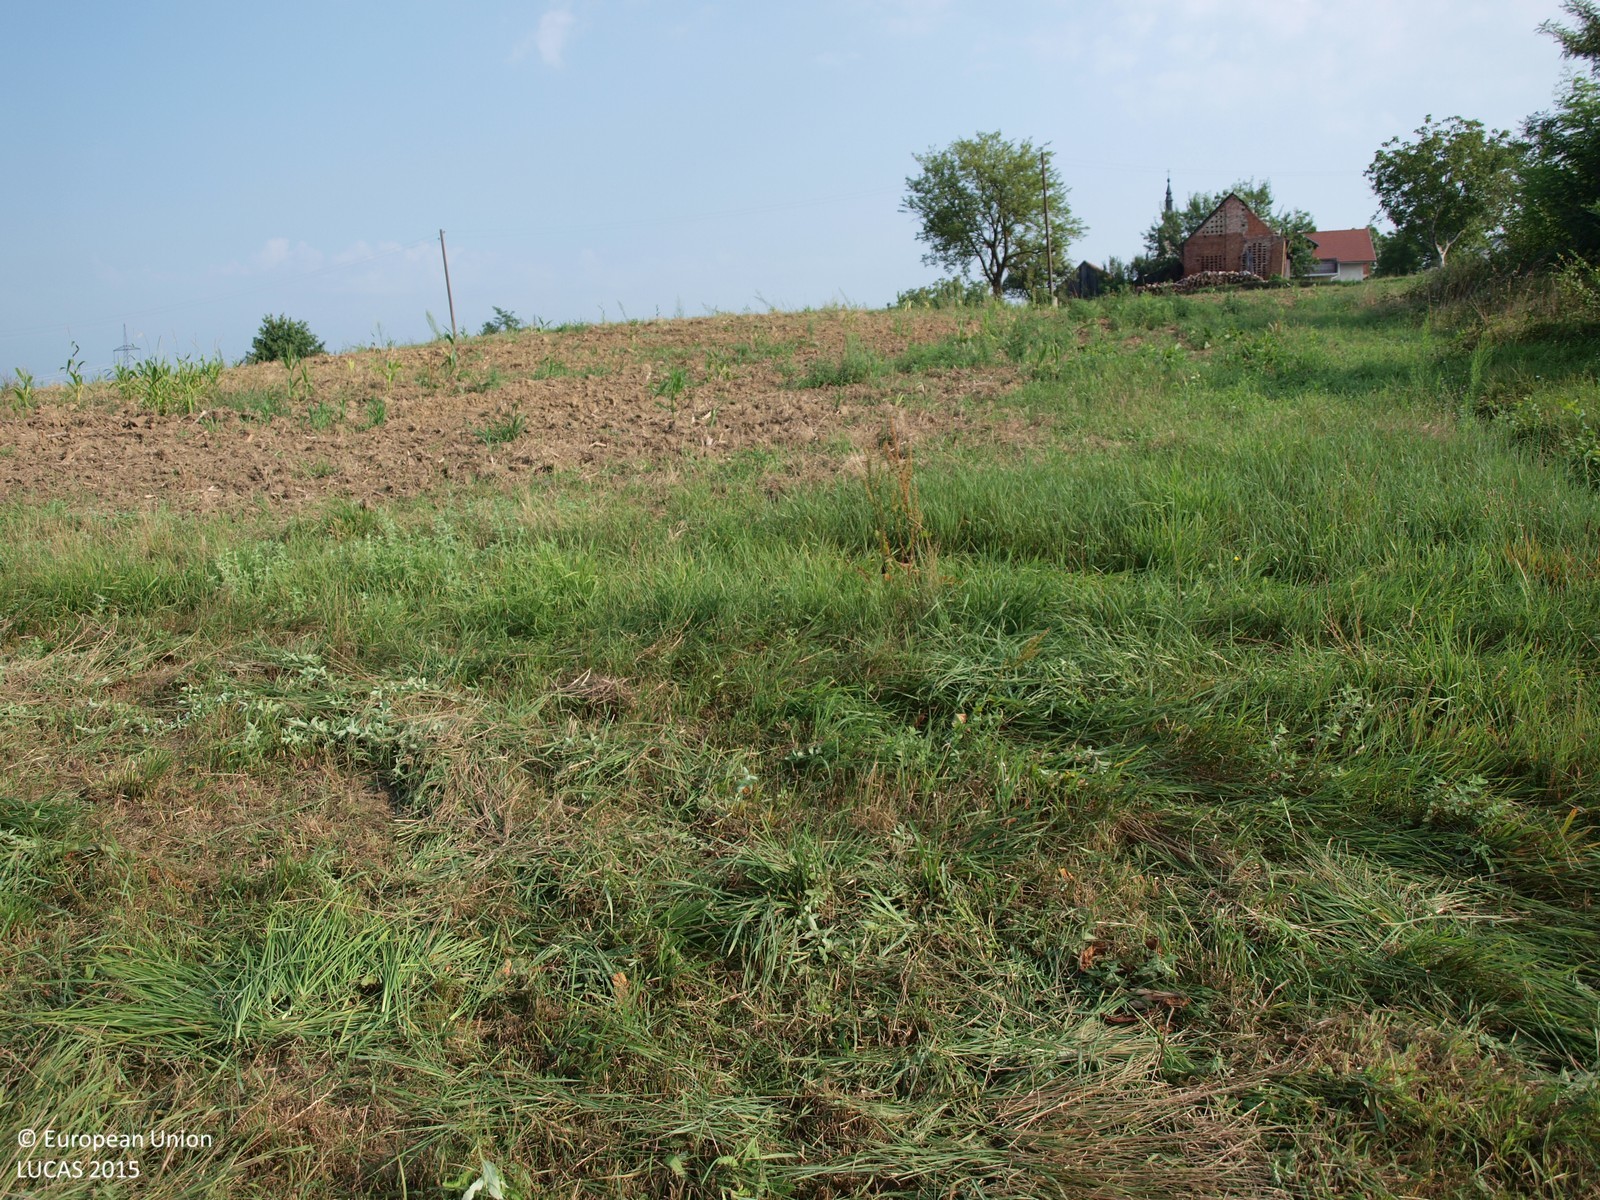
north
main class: Grassland
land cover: Grassland without tree/shrub cover
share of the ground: > 75 %
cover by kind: herbaceous plants 100 %
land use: Agriculture (excluding fallow land and kitchen gardens)
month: August
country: HR
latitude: 45.9436
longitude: 16.3844
